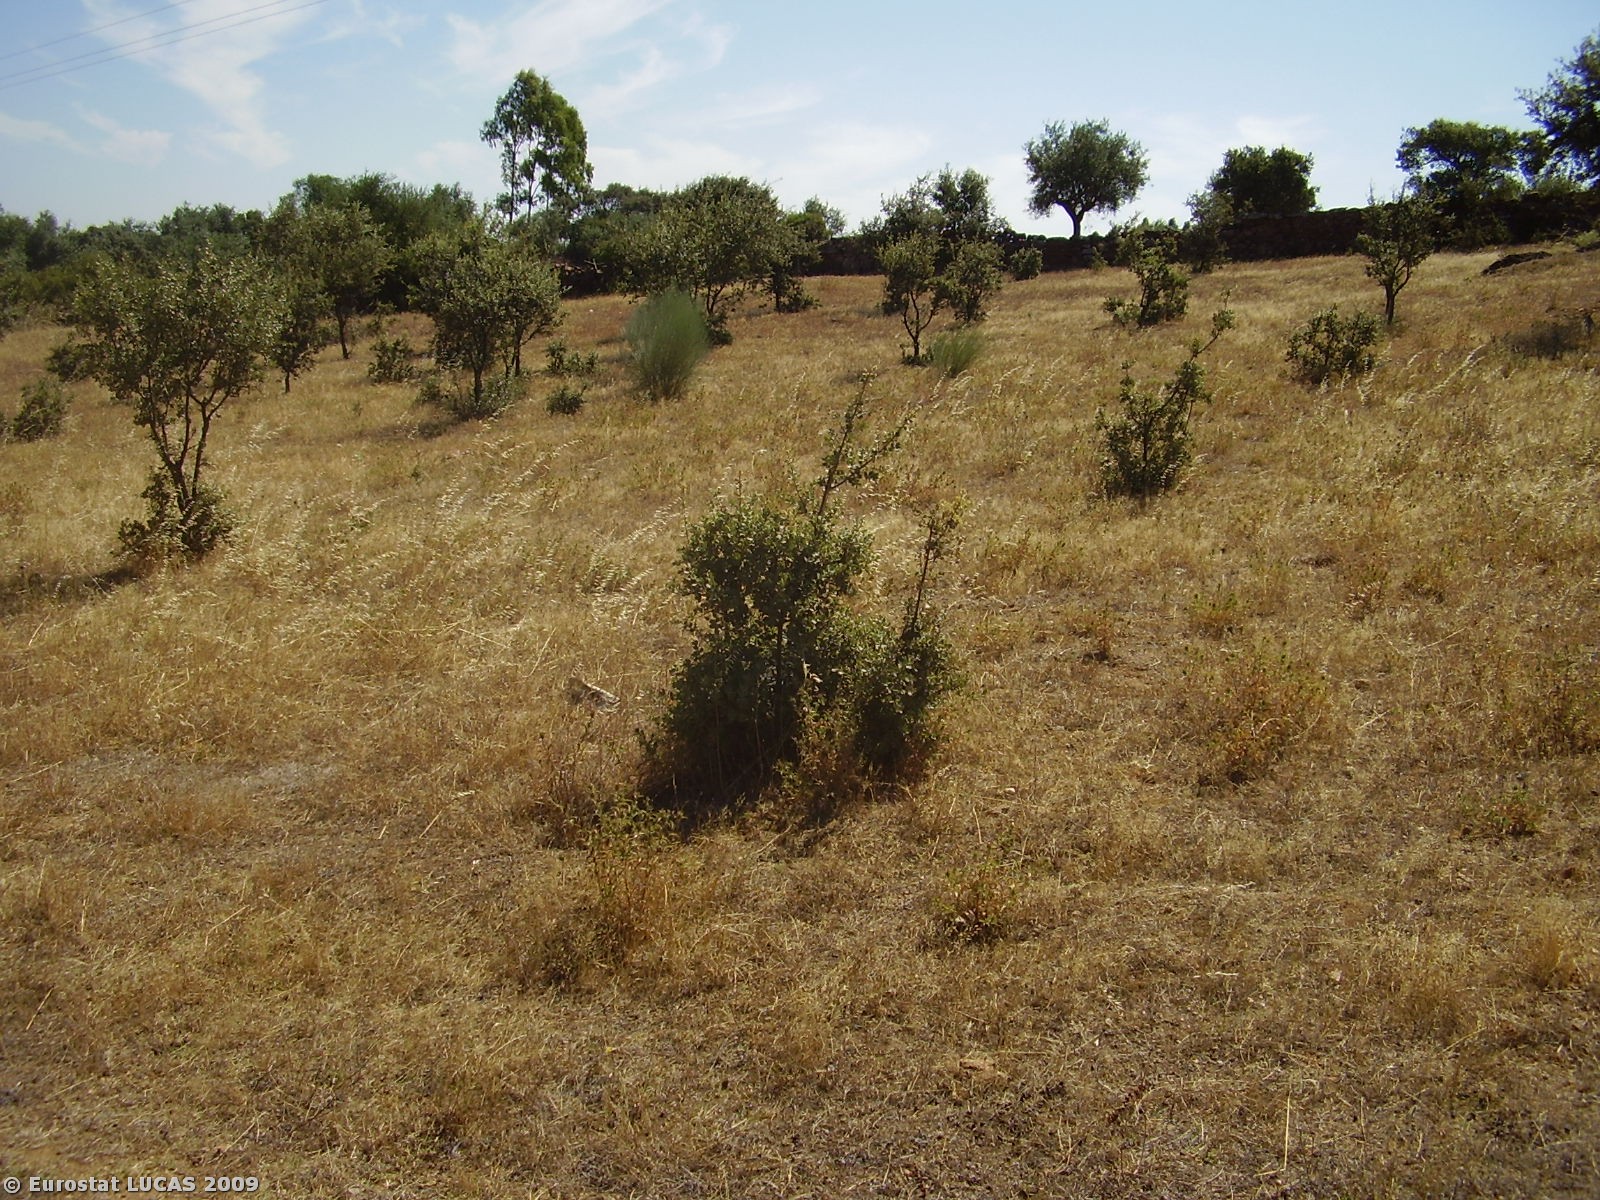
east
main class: Woodland
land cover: Broadleaved woodland
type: broadleaved evergreen forest
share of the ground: 10 - 25 %
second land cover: Grassland with sparse tree/shrub cover
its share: 50 - 75 %
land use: Forestry
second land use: Fallow land
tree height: > 5 m
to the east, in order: Broadleaved woodland; Grassland with sparse tree/shrub cover; Broadleaved woodland; Dry stone walls; Olive groves; Coniferous woodland; Tracks; Electric lines; Lines of trees; Artificial constructions in urban areas; Other citrus fruit; Rivers and streams; Lines of trees; Other fruit trees and berries; Lines of trees; Olive groves
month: July
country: PT
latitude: 38.7211
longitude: -7.9751
